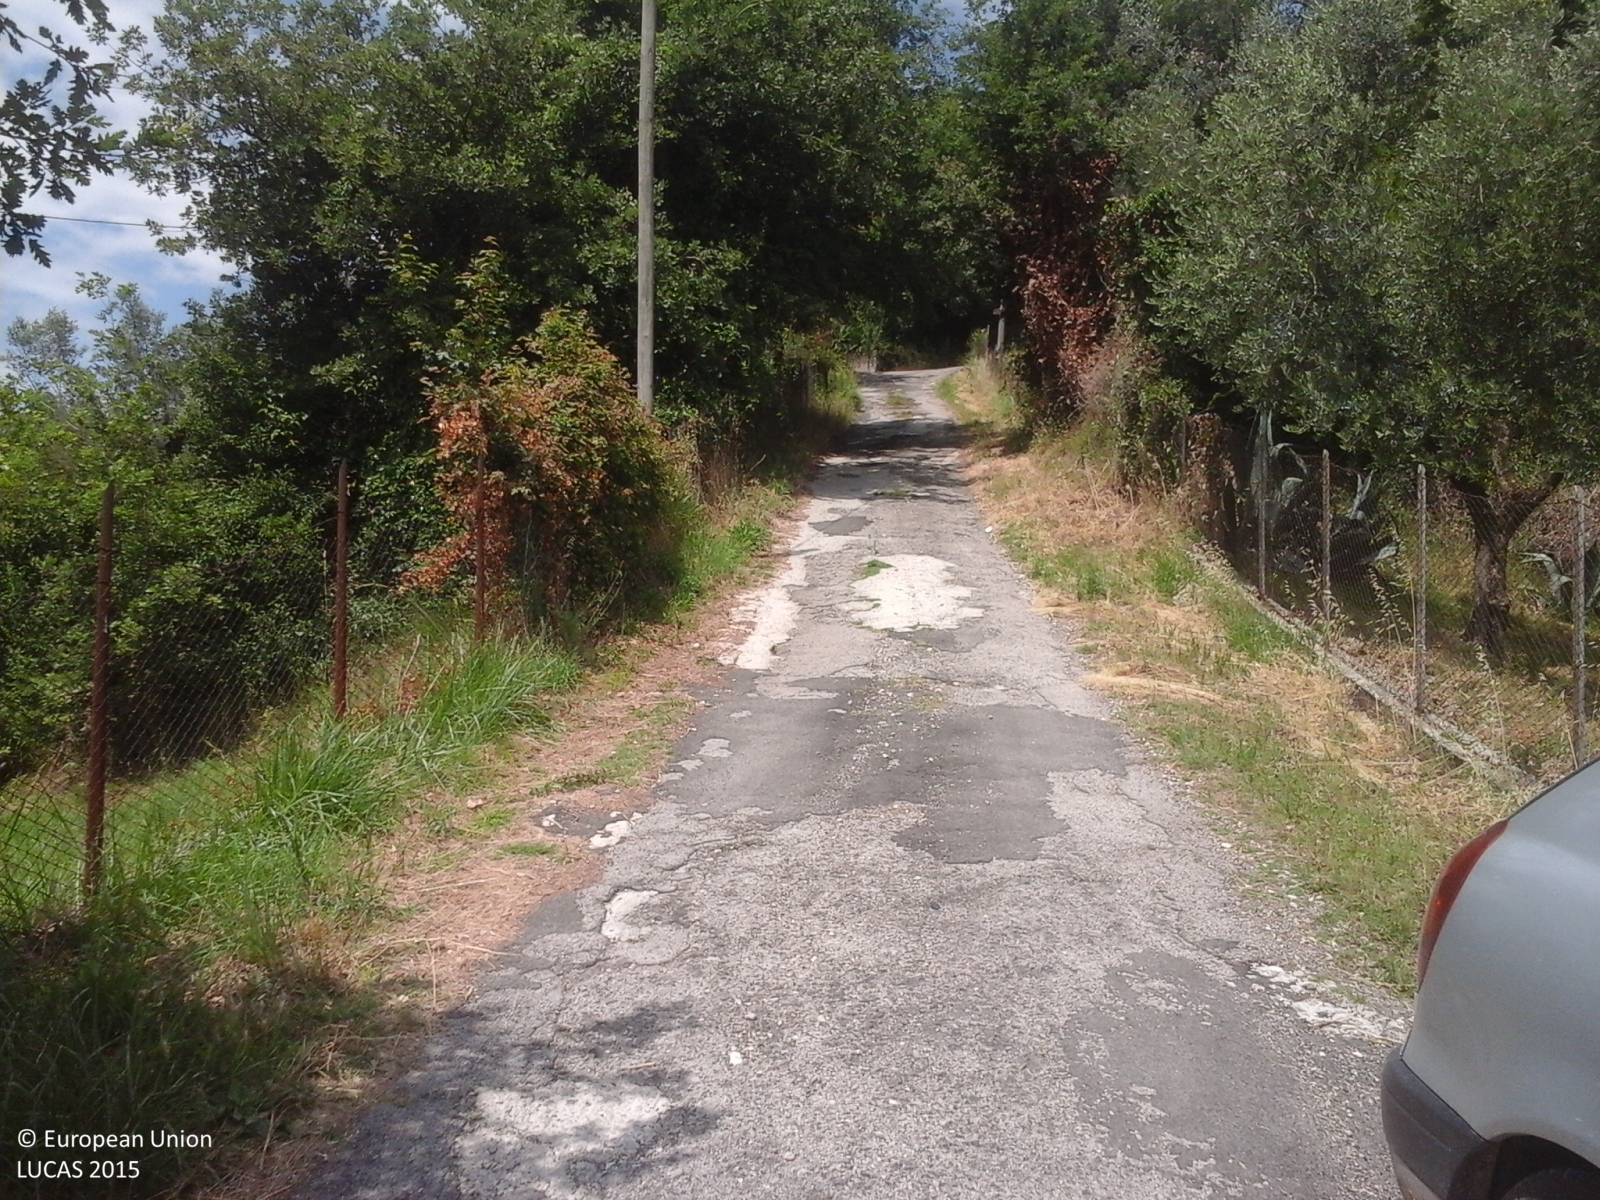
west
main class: Cropland
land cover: Olive groves
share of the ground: 50 - 75 %
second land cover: Grassland without tree/shrub cover
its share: > 75 %
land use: Agriculture (excluding fallow land and kitchen gardens)
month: June
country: IT
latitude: 41.7364
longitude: 13.1743
